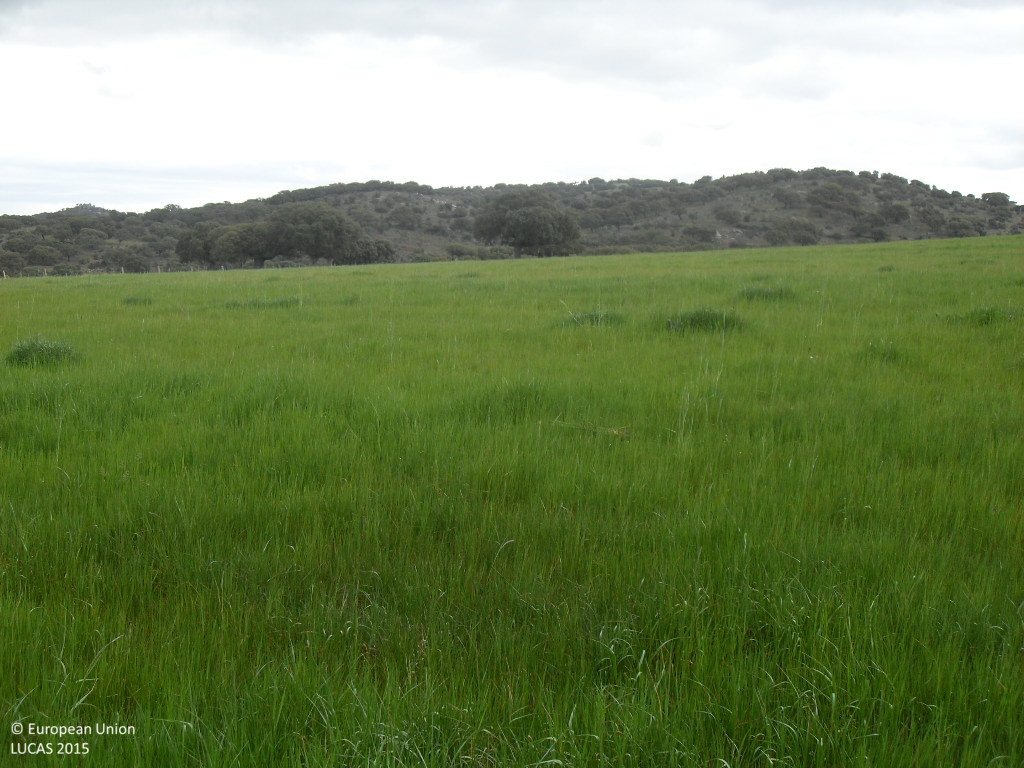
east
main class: Woodland
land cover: Broadleaved woodland
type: broadleaved evergreen forest
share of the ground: 10 - 25 %
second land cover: Temporary grasslands
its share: > 75 %
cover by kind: herbaceous plants 80 %, broadleaved forest trees 20 %
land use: Forestry
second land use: Agriculture (excluding fallow land and kitchen gardens)
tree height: > 5 m
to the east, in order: Broadleaved woodland; Temporary grasslands; Dry stone walls; Grass margins; Tracks; Grass margins; Fences; Broadleaved woodland
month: April
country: ES
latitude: 40.6912
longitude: -5.3201
